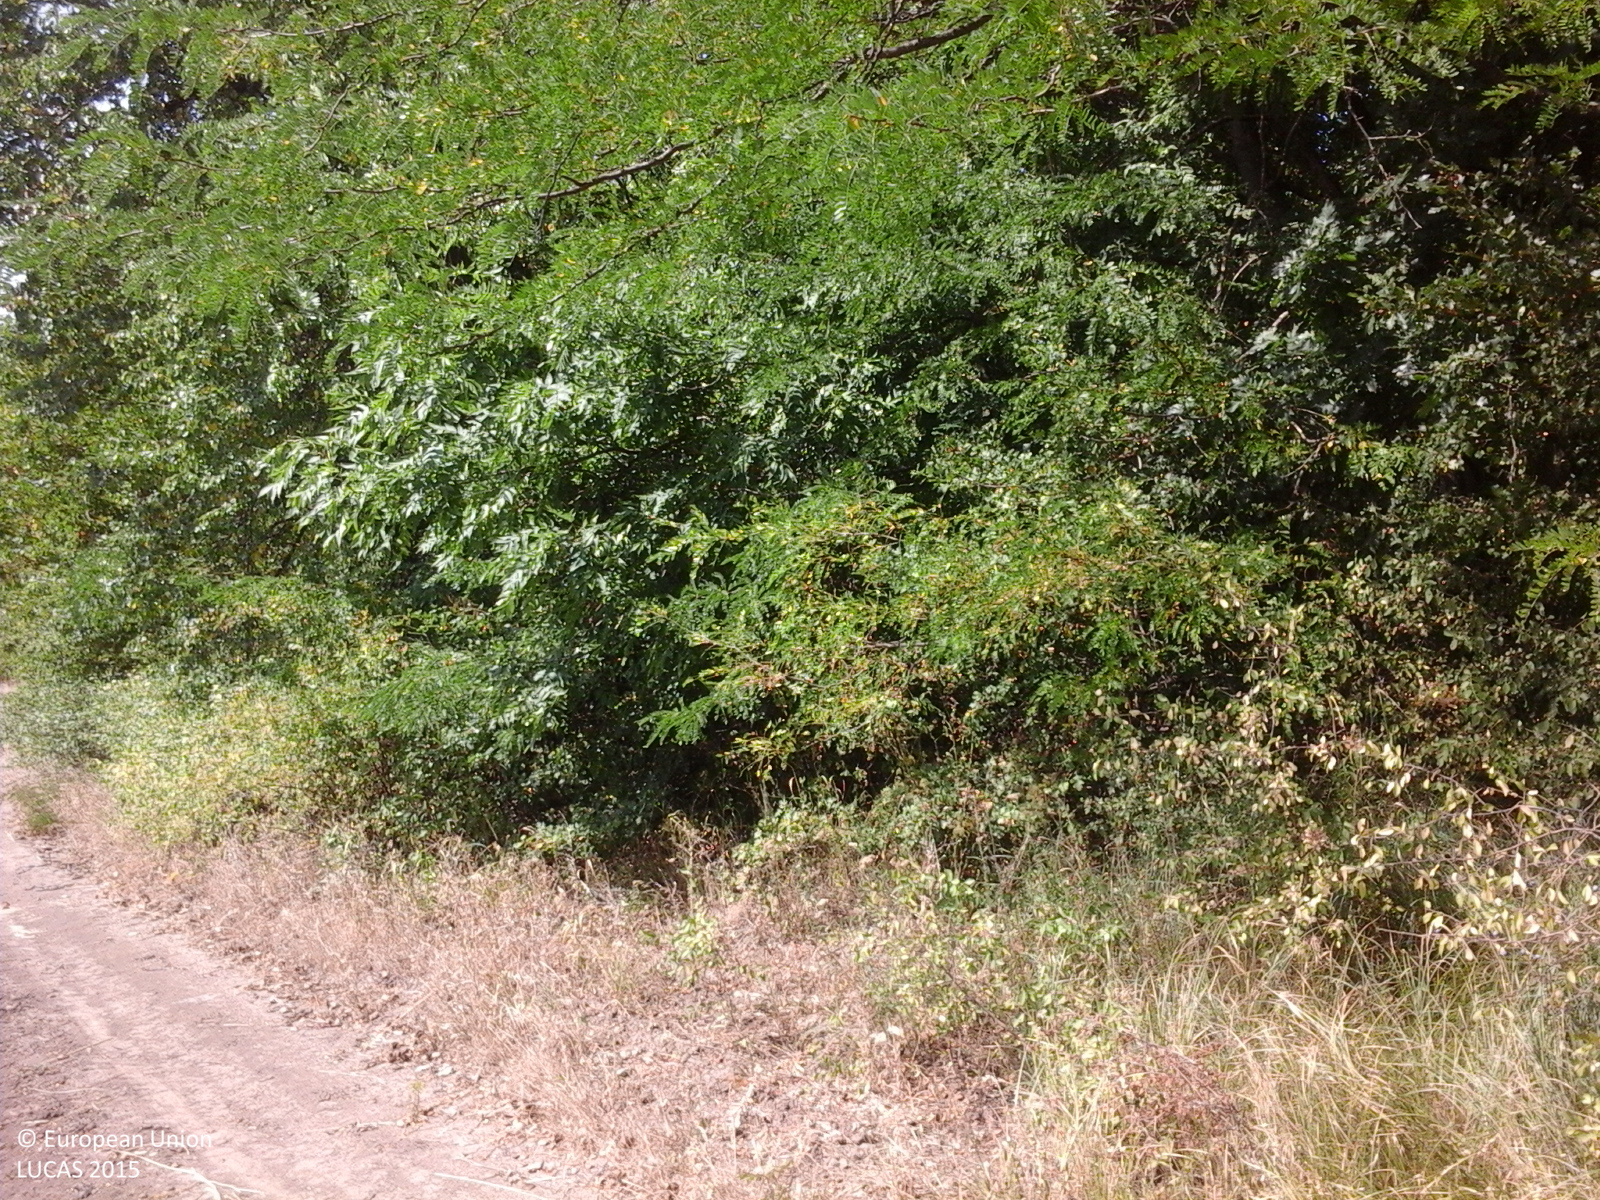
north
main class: Woodland
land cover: Broadleaved woodland
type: acidophilous oak and oak-birch forest
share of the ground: > 75 %
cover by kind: broadleaved forest trees 100 %
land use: Forestry
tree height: > 5 m
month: July
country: RO
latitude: 46.2093
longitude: 27.8905
